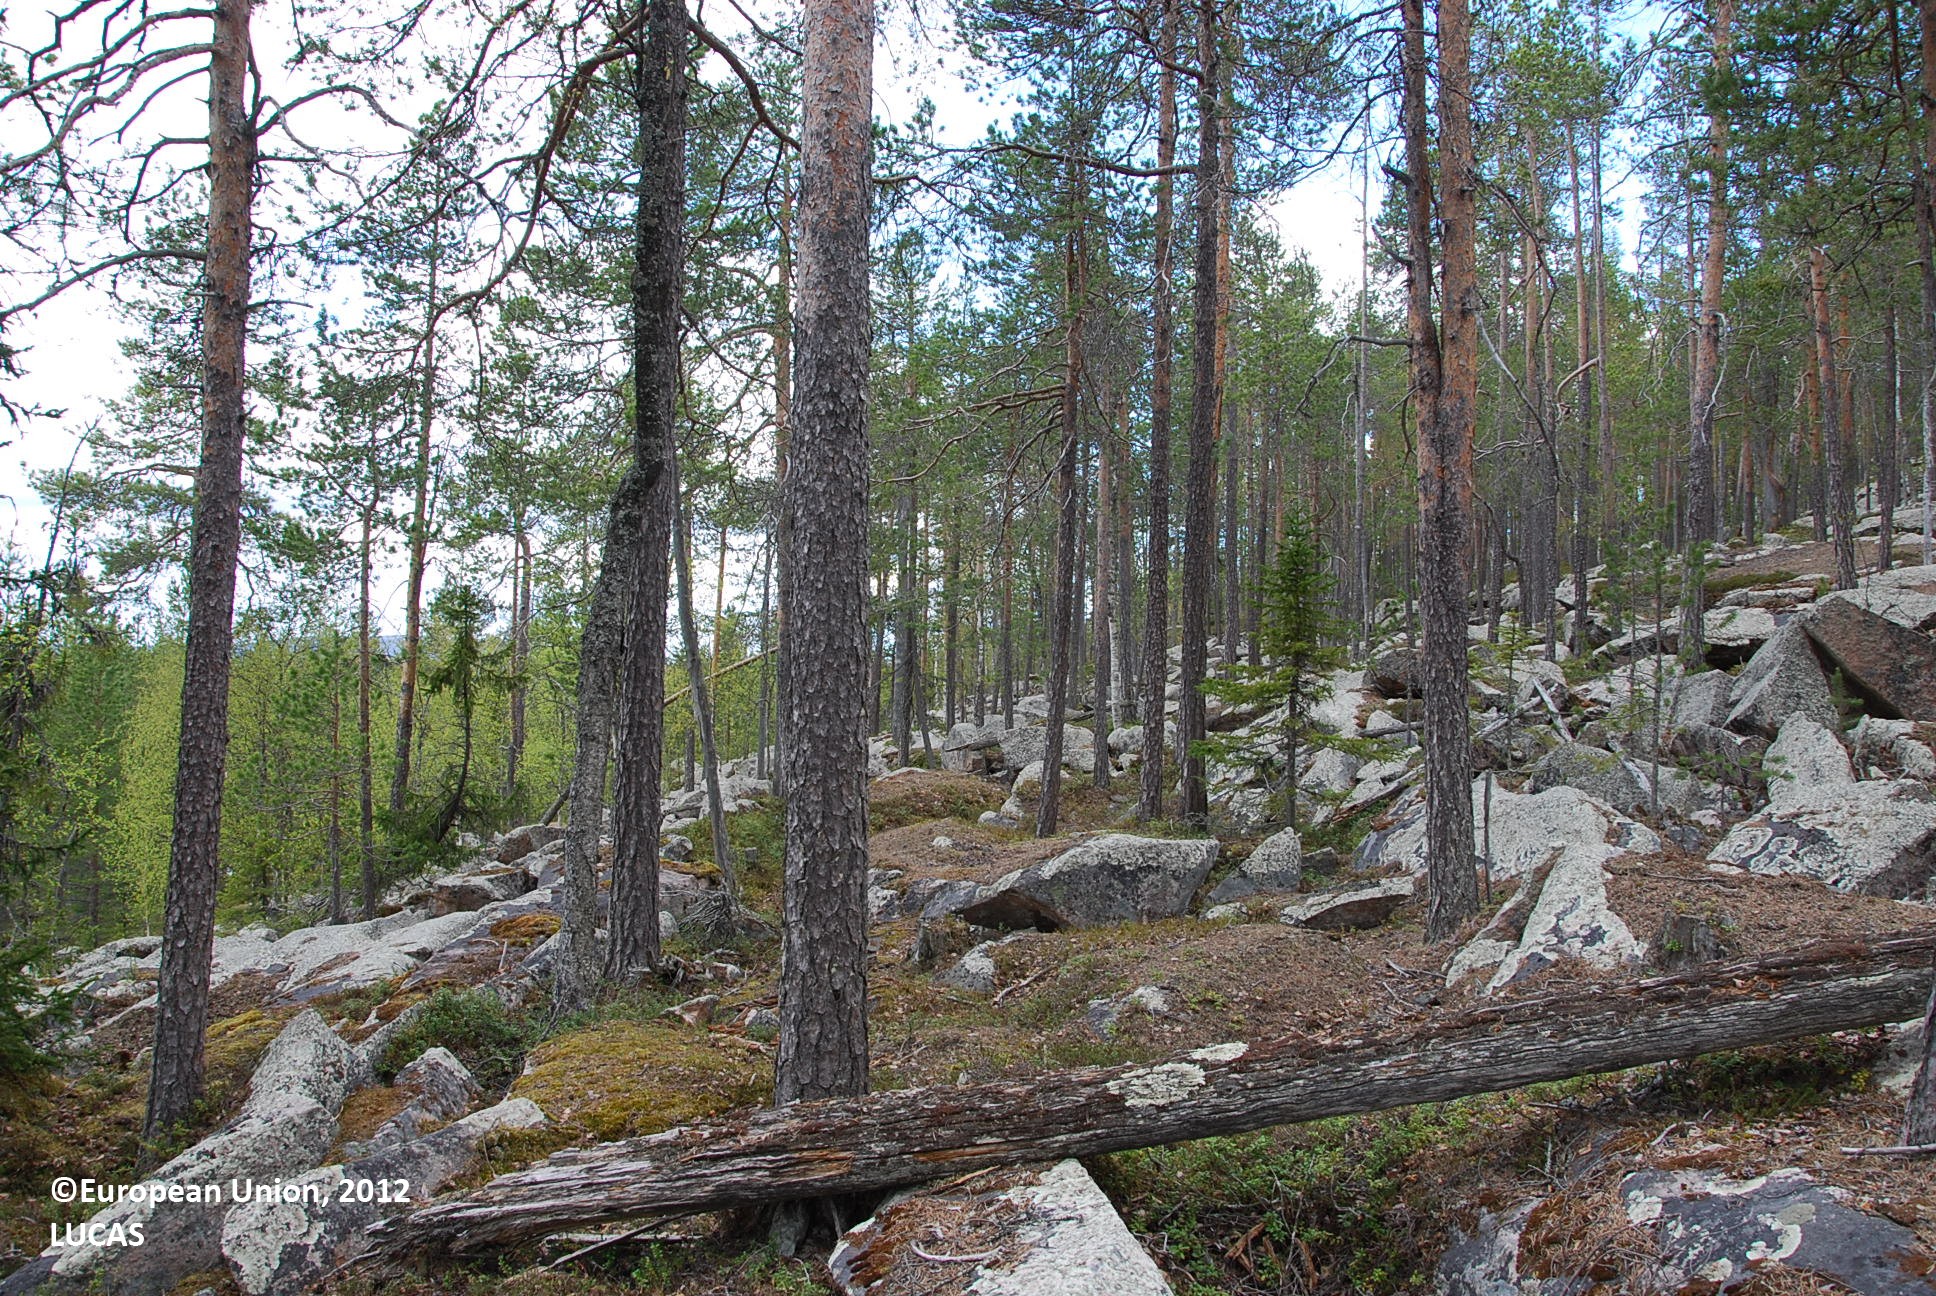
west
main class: Woodland
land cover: Pine dominated coniferous woodland
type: boreal forest
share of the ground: 25 - 50 %
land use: Forestry
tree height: > 5 m
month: May
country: FI
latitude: 66.8914
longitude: 28.2842
